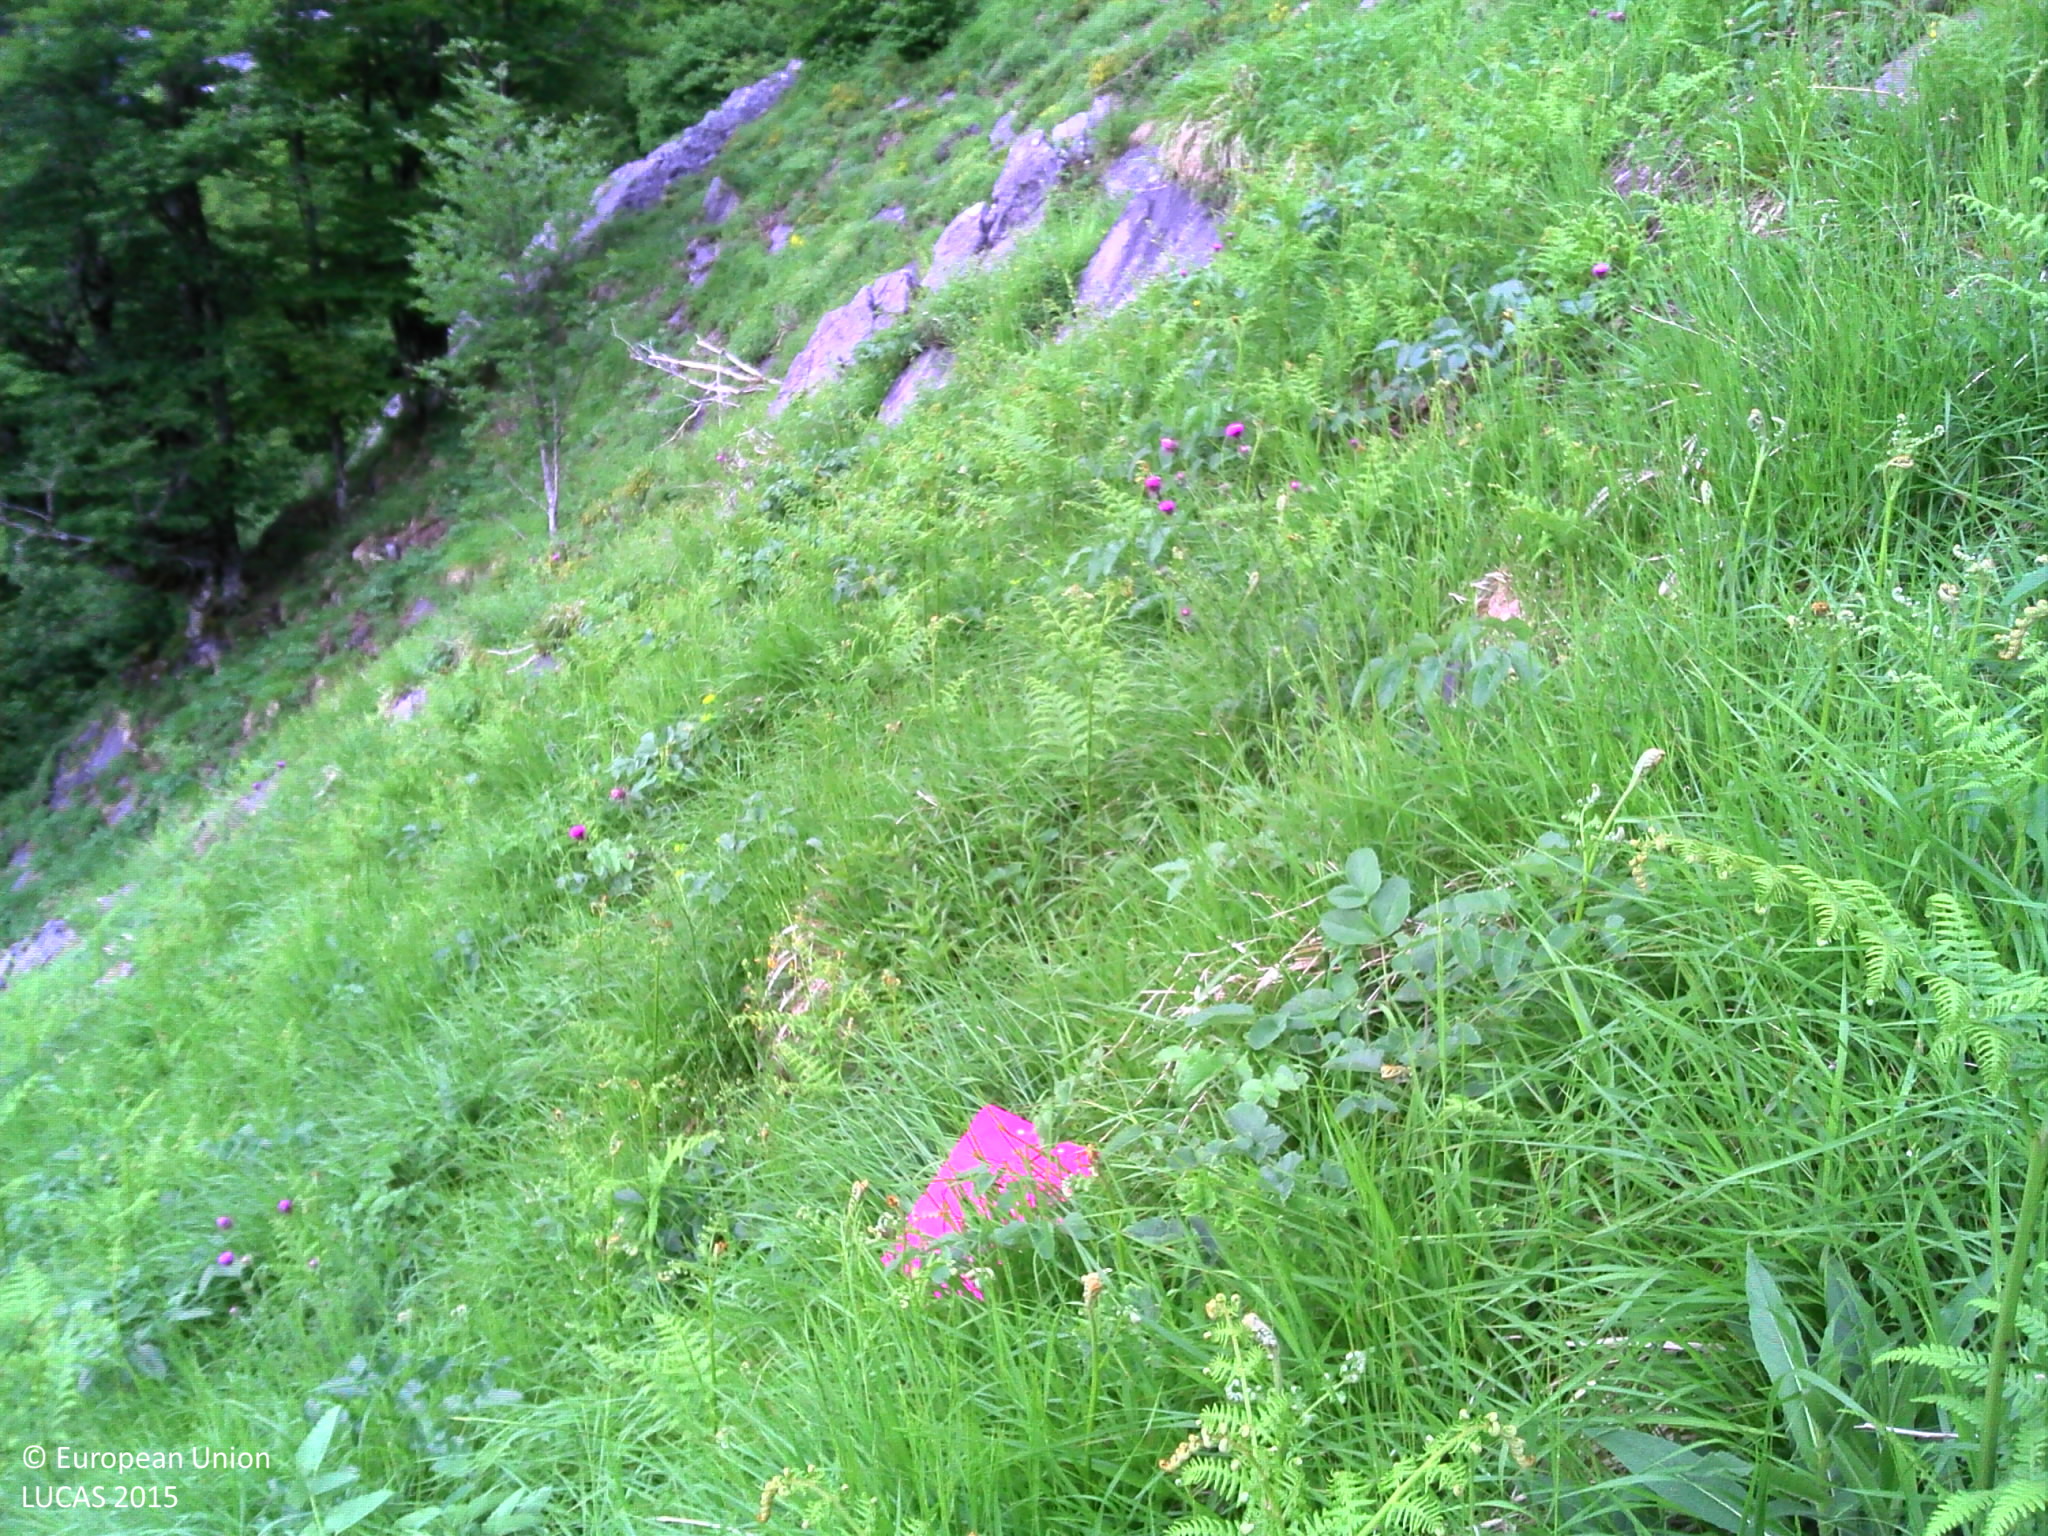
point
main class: Grassland
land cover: Grassland with sparse tree/shrub cover
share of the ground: > 75 %
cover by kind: herbaceous plants 85 %, shrubs 10 %, broadleaved forest trees 5 %
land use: Agriculture (excluding fallow land and kitchen gardens)
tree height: > 5 m
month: June
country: FR
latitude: 42.9455
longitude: -0.6569
